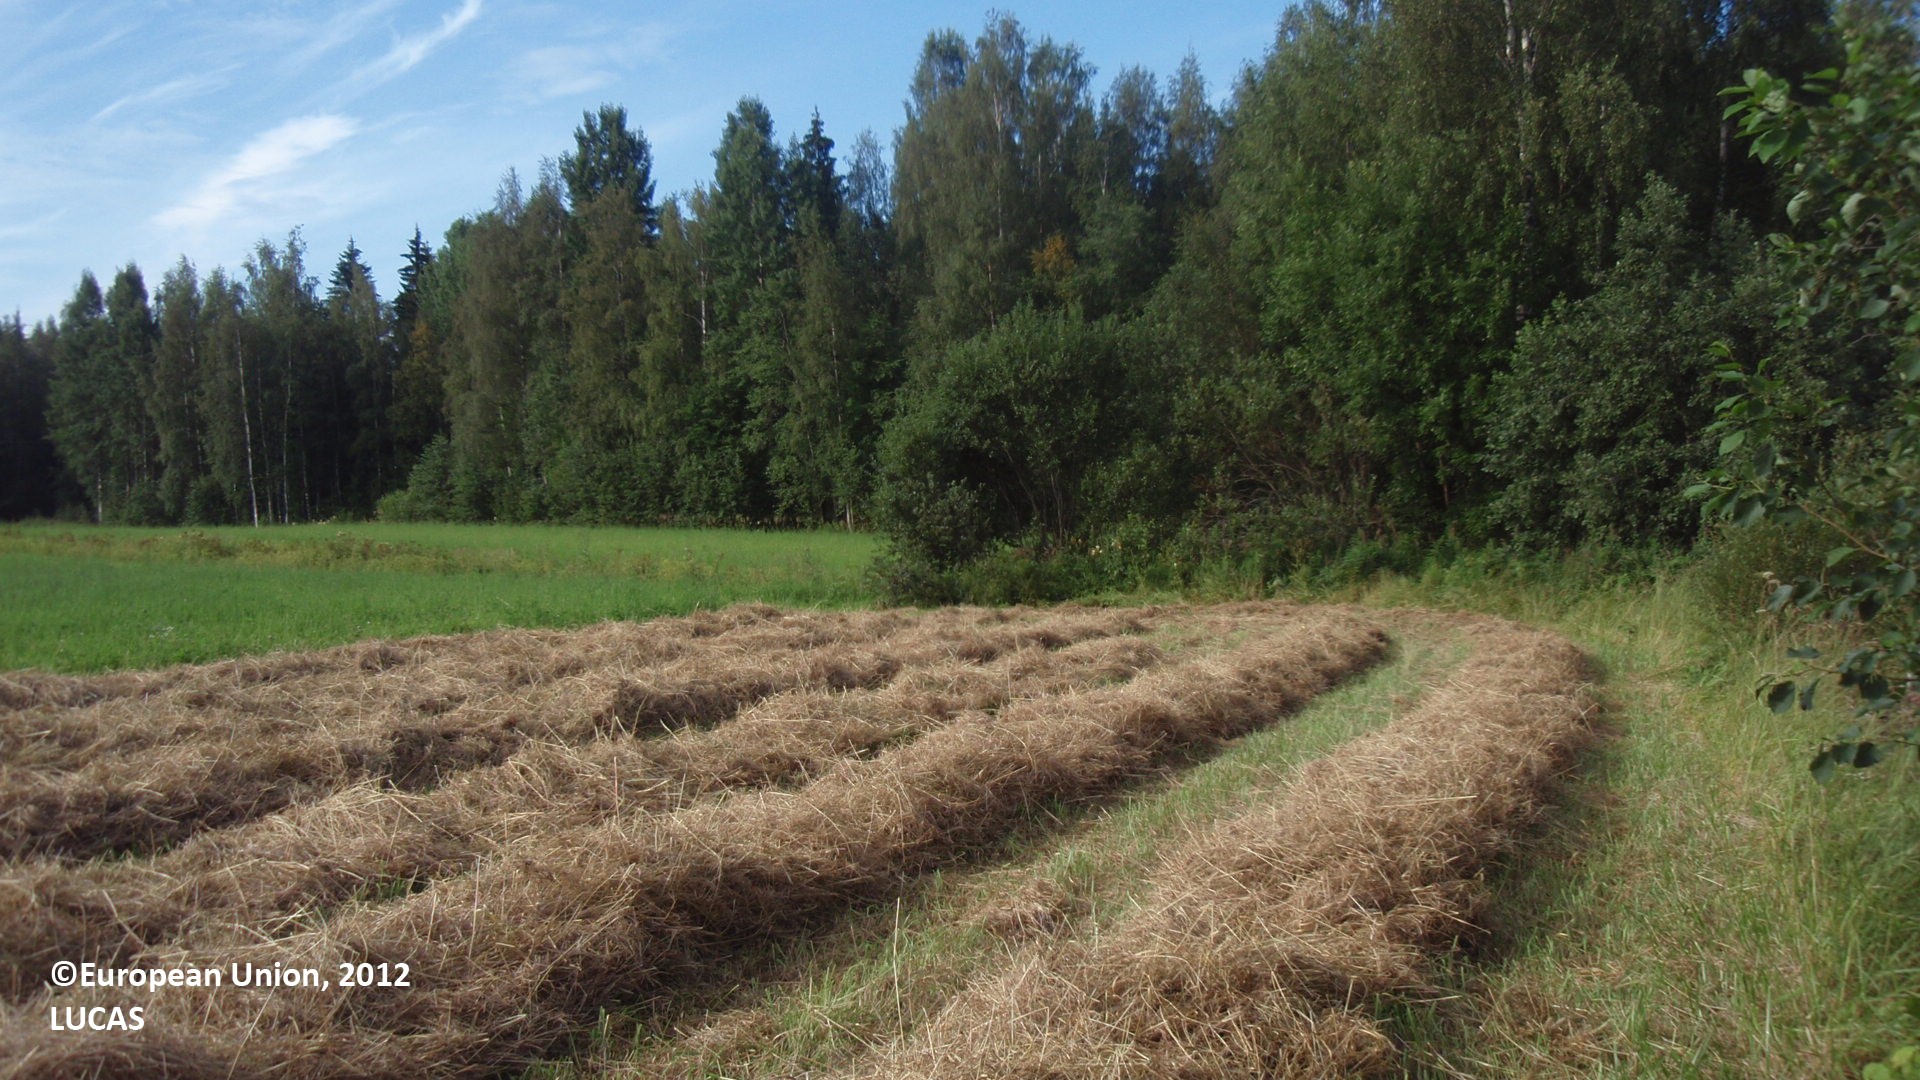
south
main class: Cropland
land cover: Mixed cereals for fodder
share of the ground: > 75 %
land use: Agriculture (excluding fallow land and kitchen gardens)
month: August
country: FI
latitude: 61.2134
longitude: 28.0128
